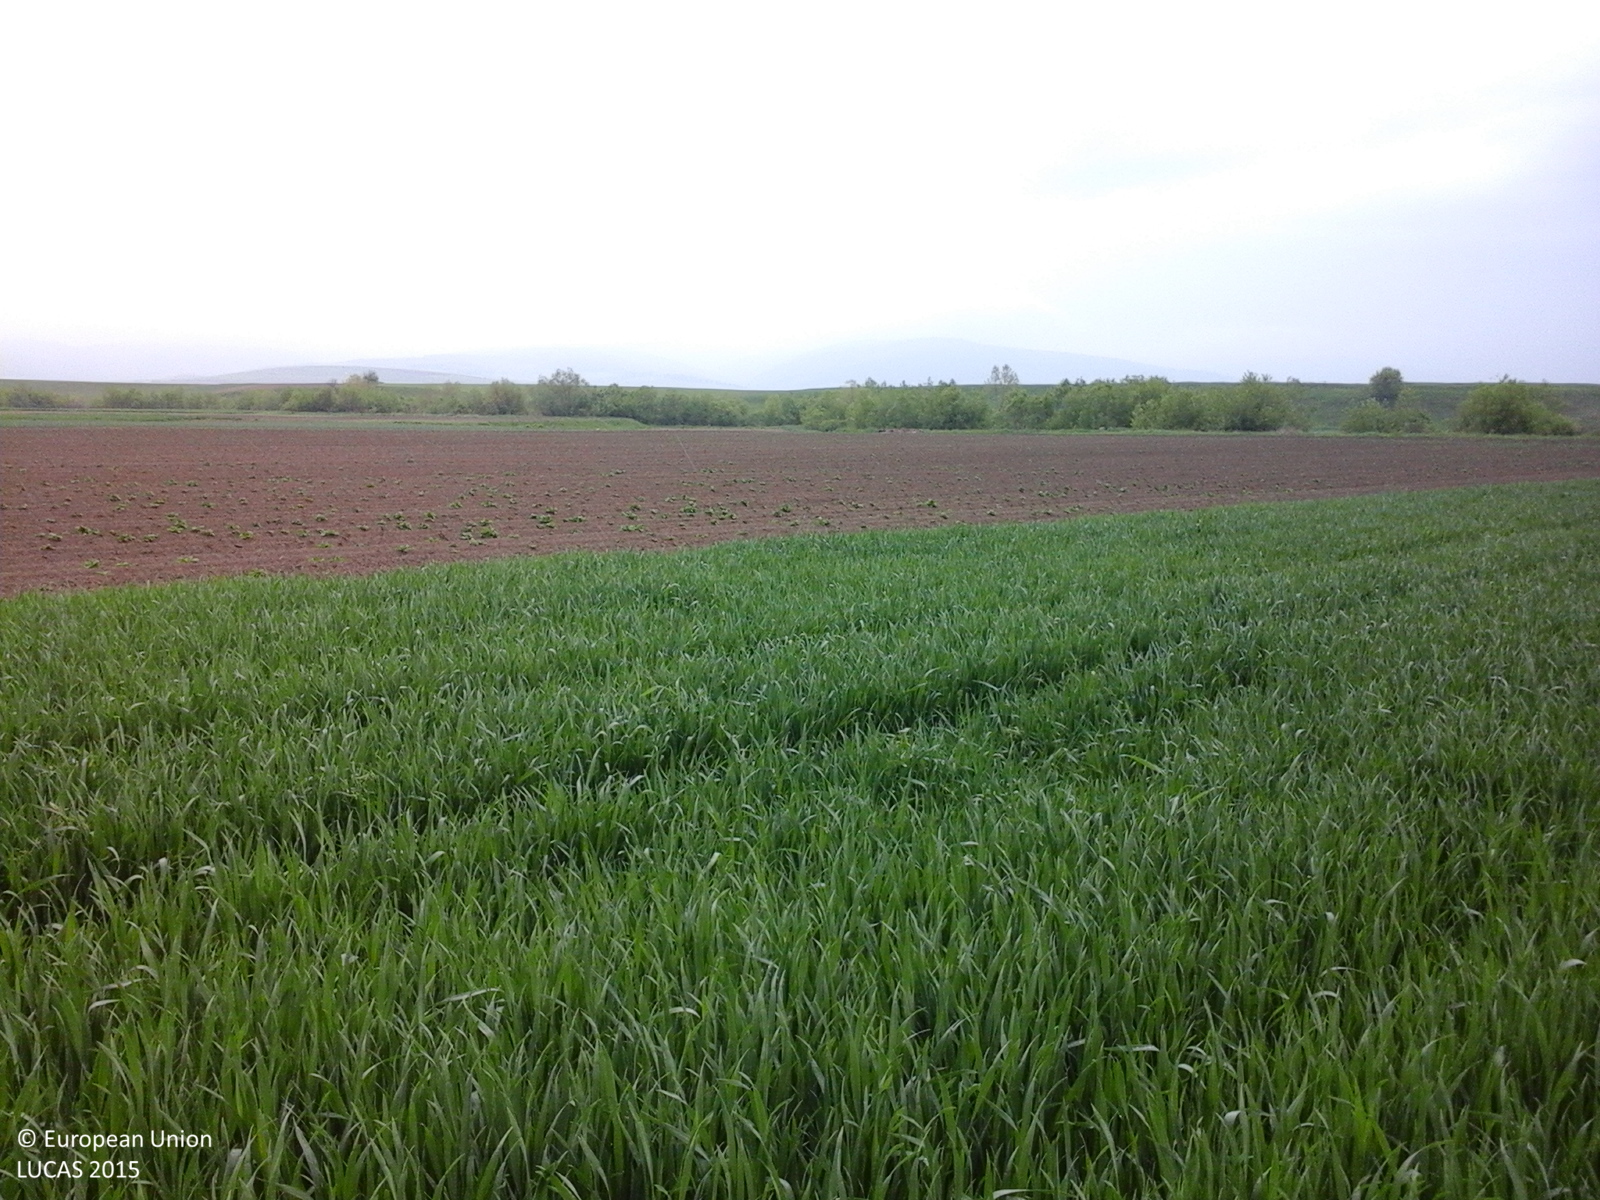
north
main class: Cropland
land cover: Common wheat
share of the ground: > 75 %
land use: Fallow land
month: May
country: RO
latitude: 46.0209
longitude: 26.0984
